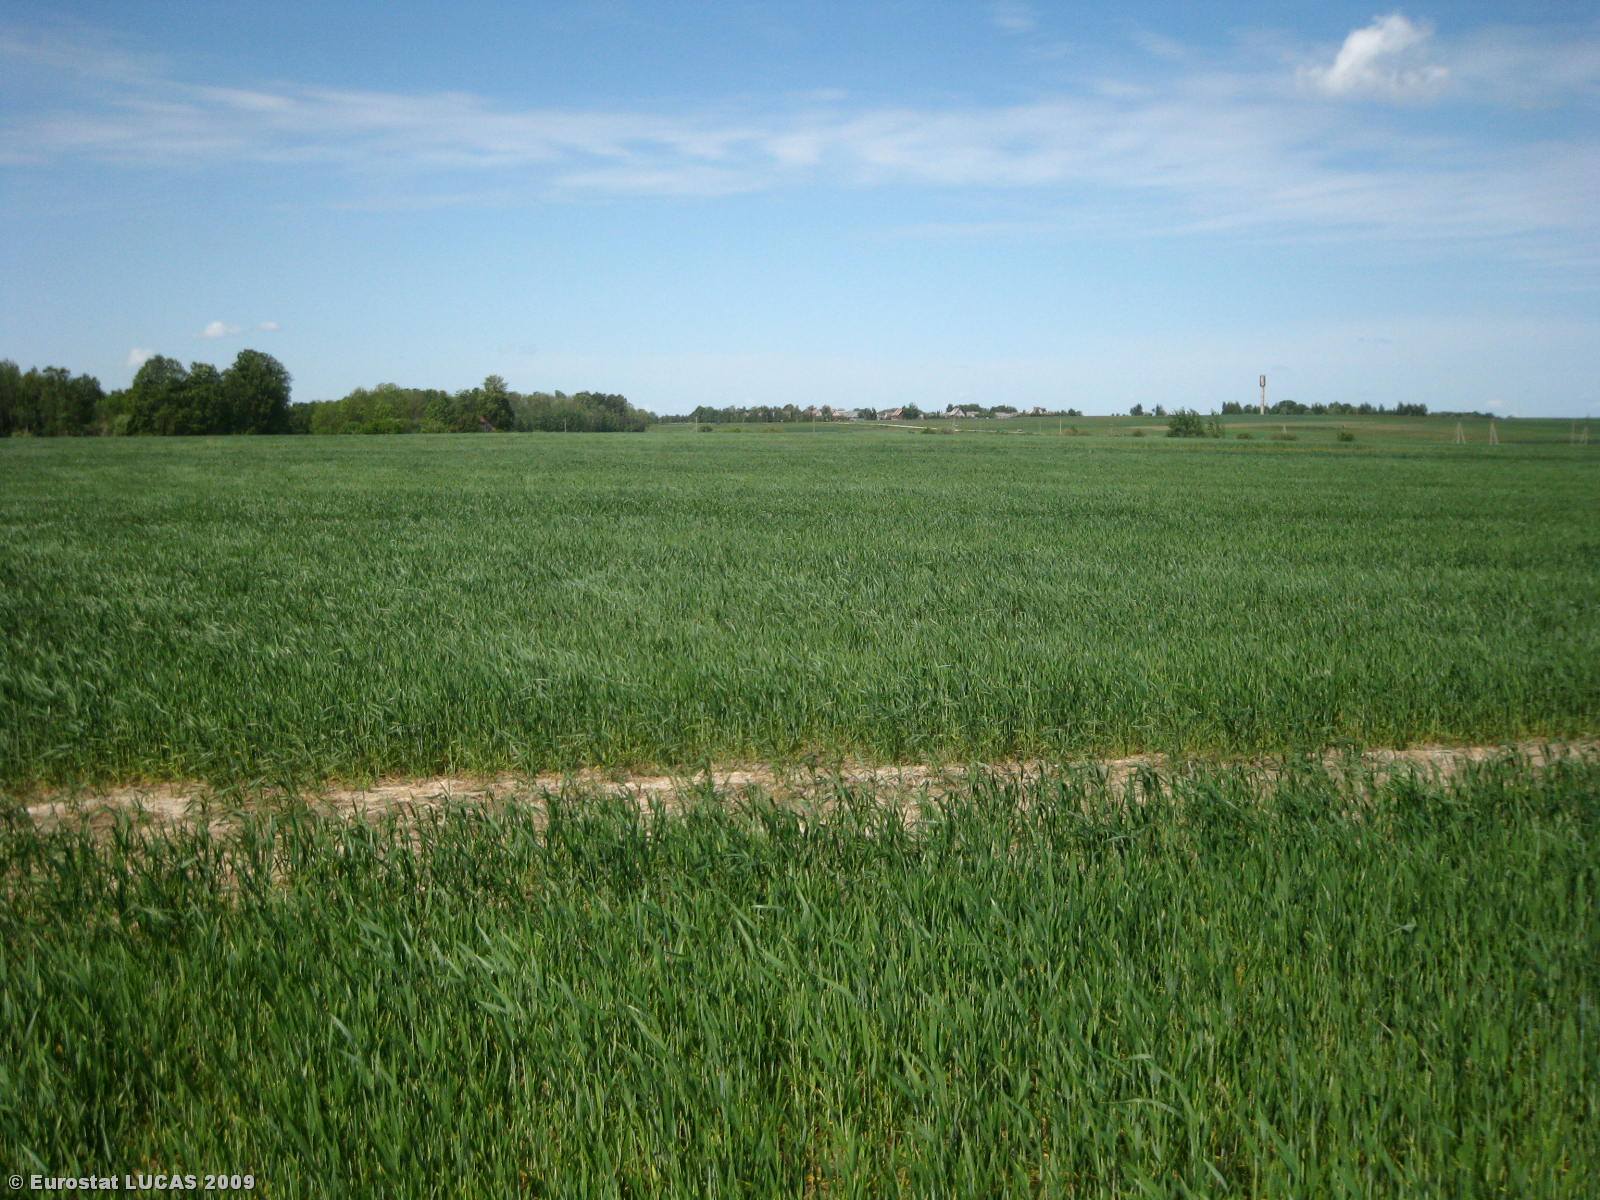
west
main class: Cropland
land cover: Common wheat
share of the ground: > 75 %
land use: Agriculture (excluding fallow land and kitchen gardens)
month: May
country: LT
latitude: 56.1066
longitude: 24.1923
